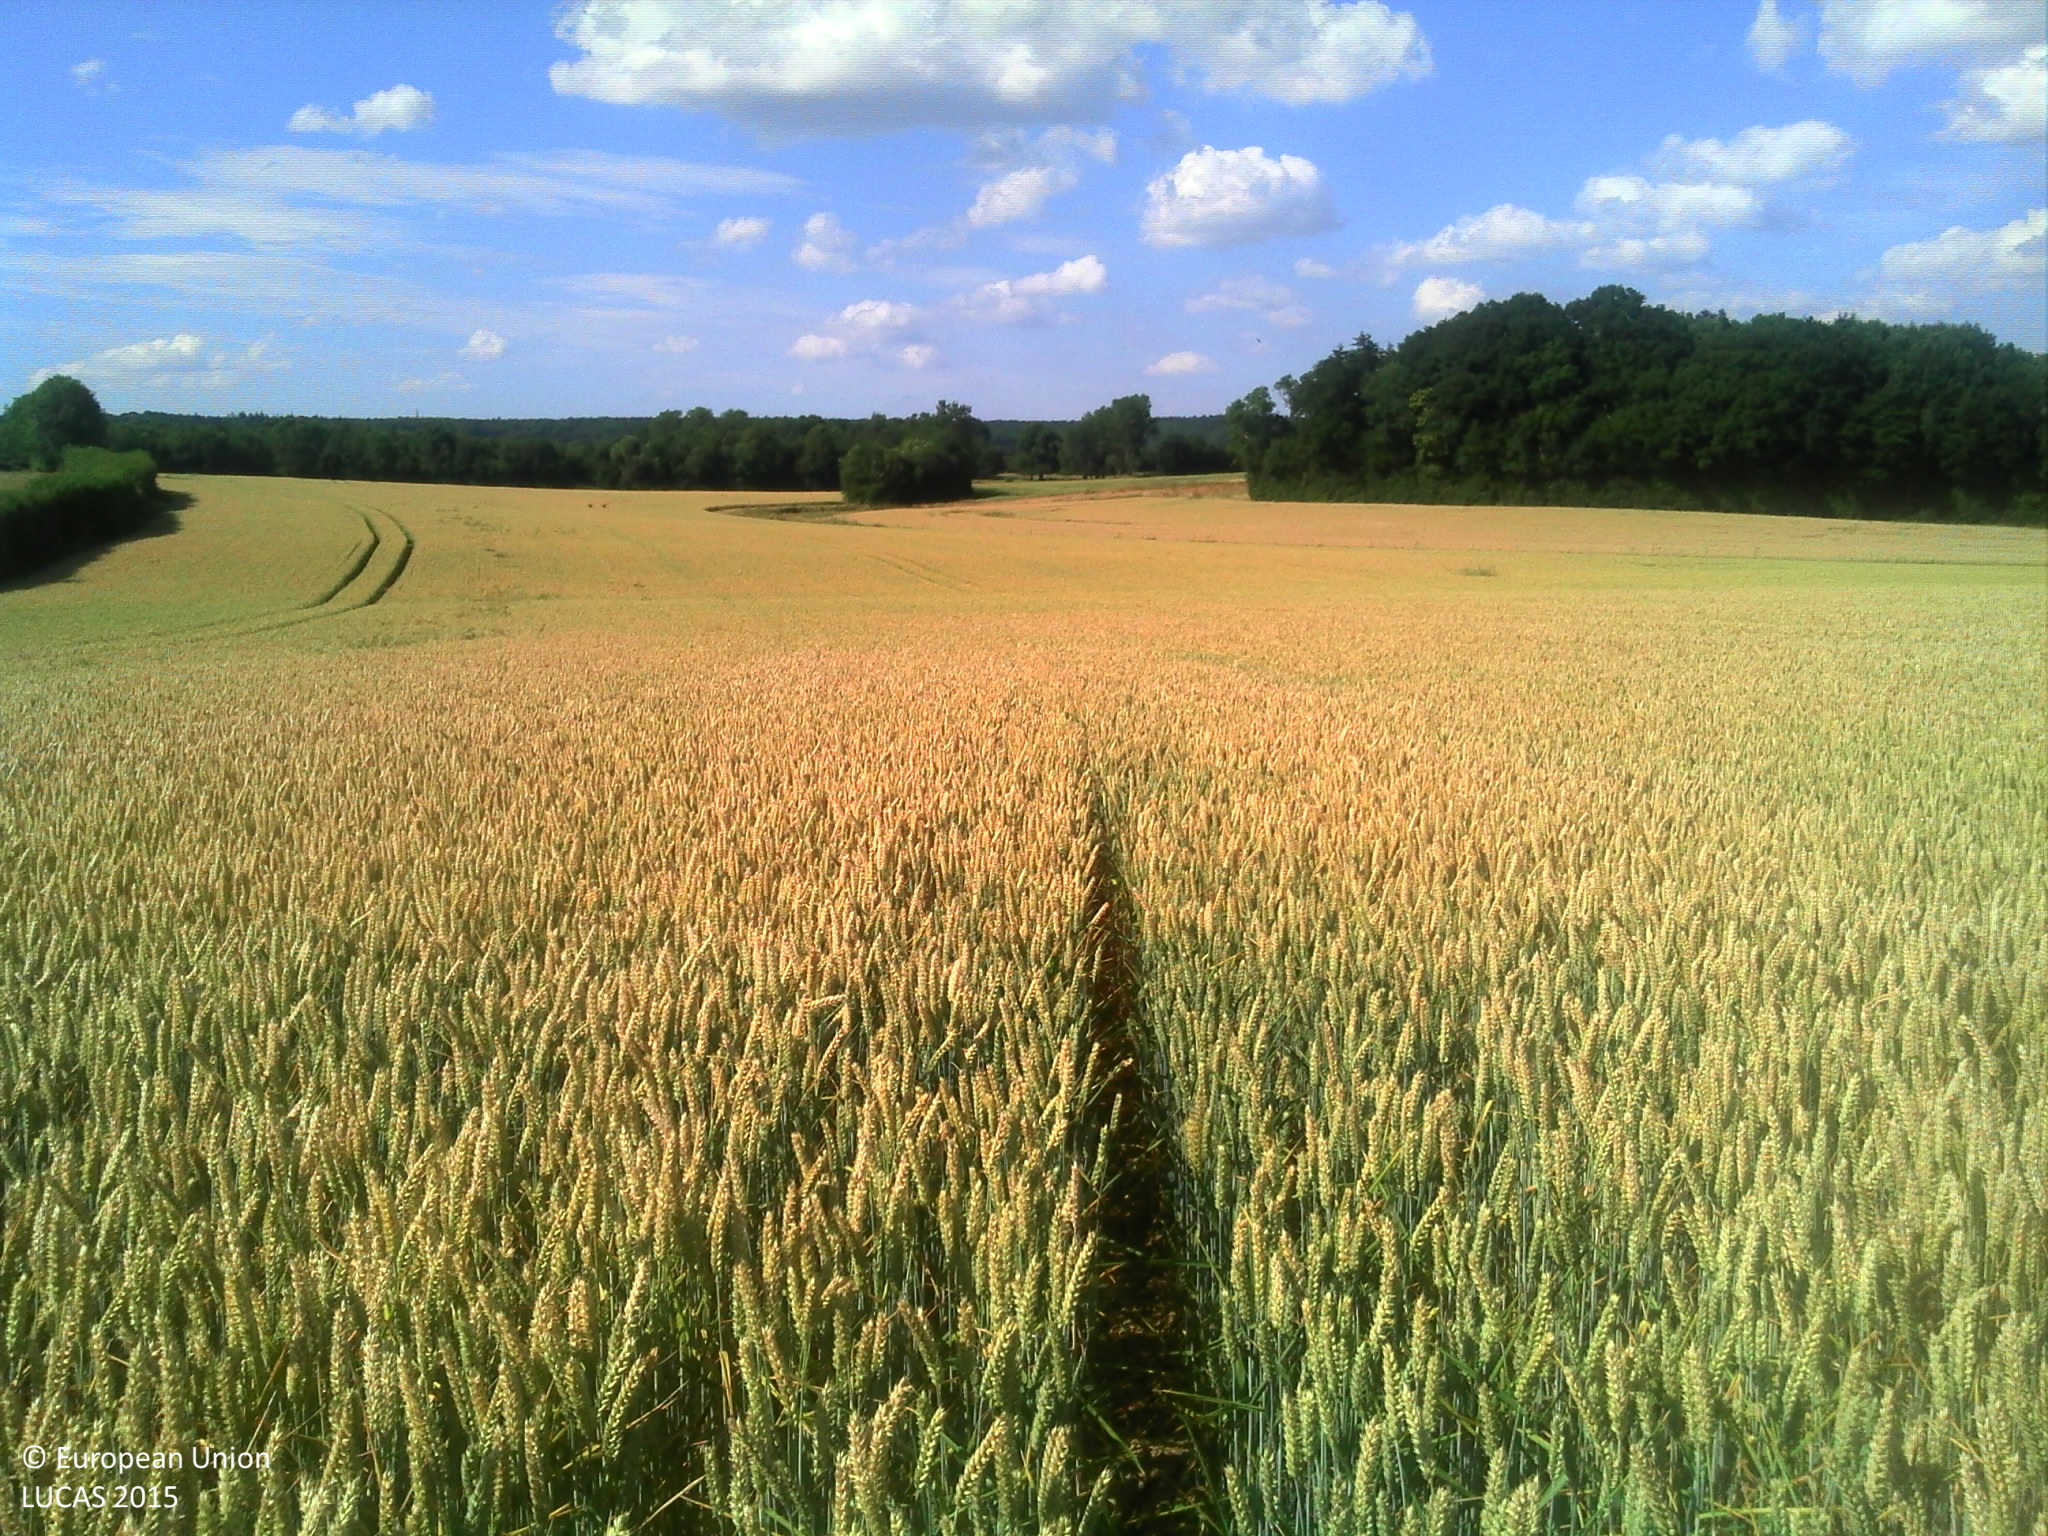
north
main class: Cropland
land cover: Common wheat
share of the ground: > 75 %
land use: Agriculture (excluding fallow land and kitchen gardens)
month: July
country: FR
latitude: 48.7315
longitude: 0.4435
